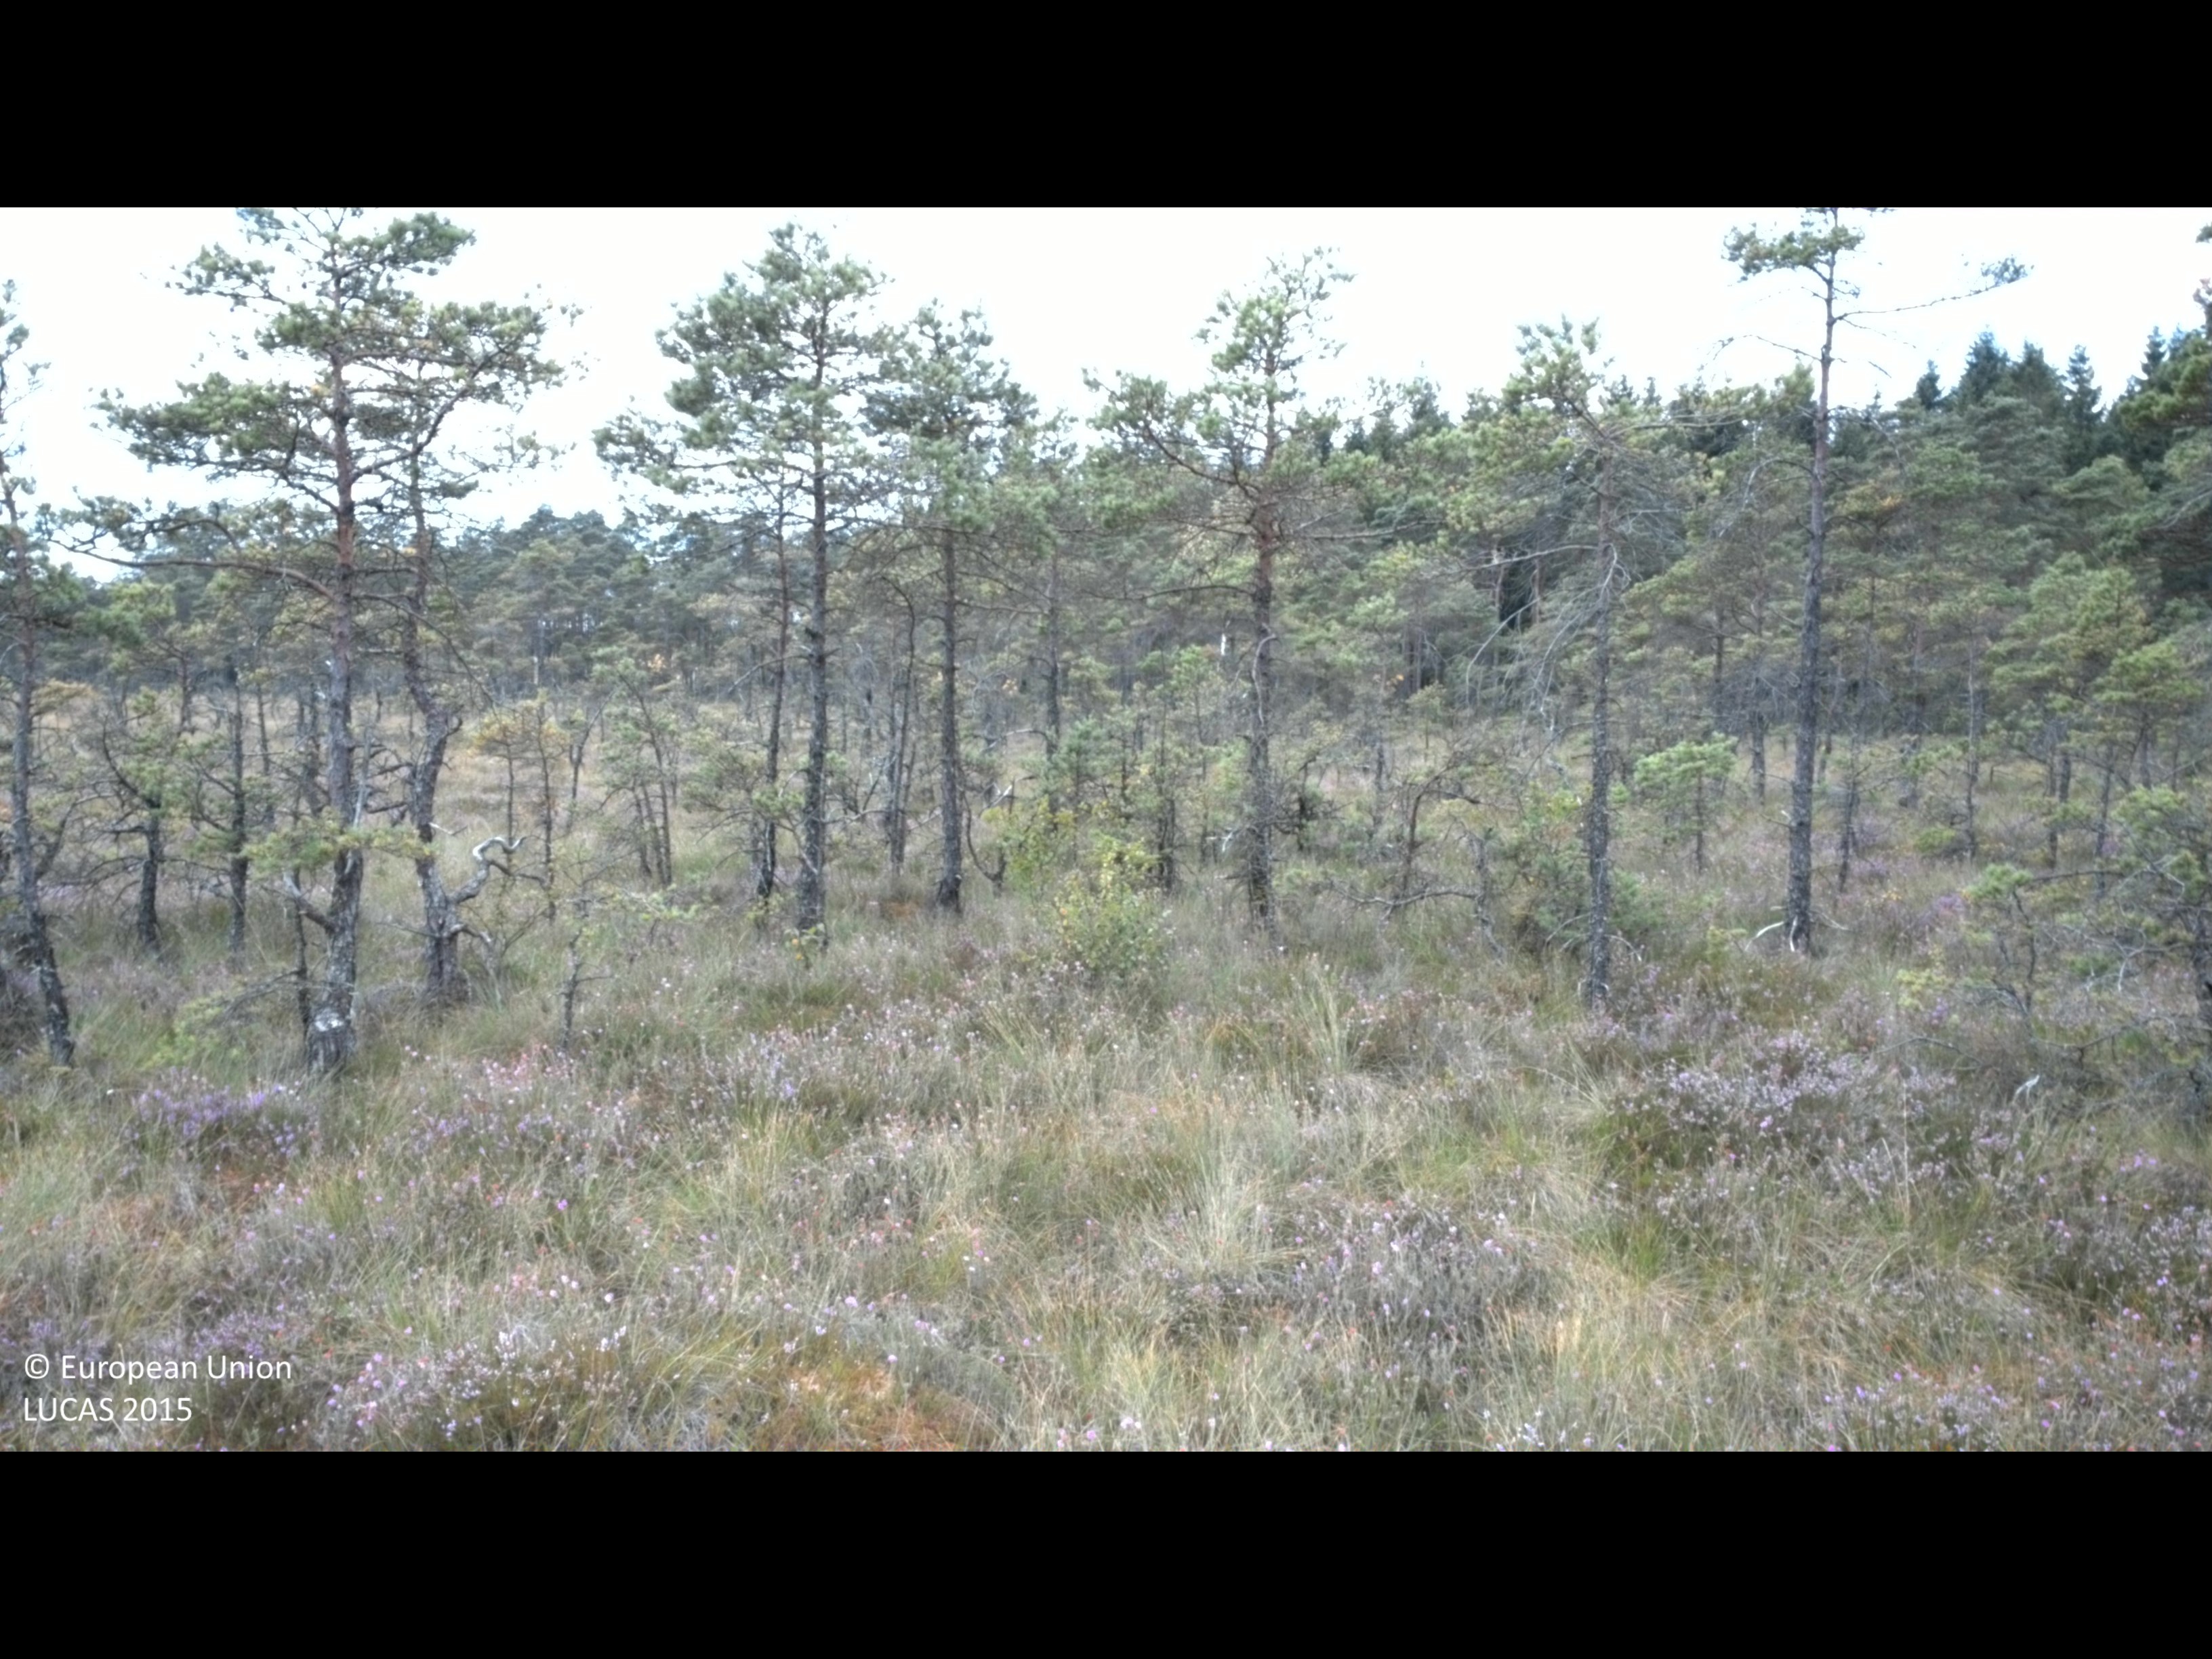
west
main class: Woodland
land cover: Pine dominated coniferous woodland
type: mire and swamp forests
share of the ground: 25 - 50 %
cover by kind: coniferous forest trees 40 %, shrubs 30 %, herbaceous plants 30 %
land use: Semi-natural and natural areas not in use
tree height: < 5 m
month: August
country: SE
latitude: 56.8677
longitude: 13.1954
